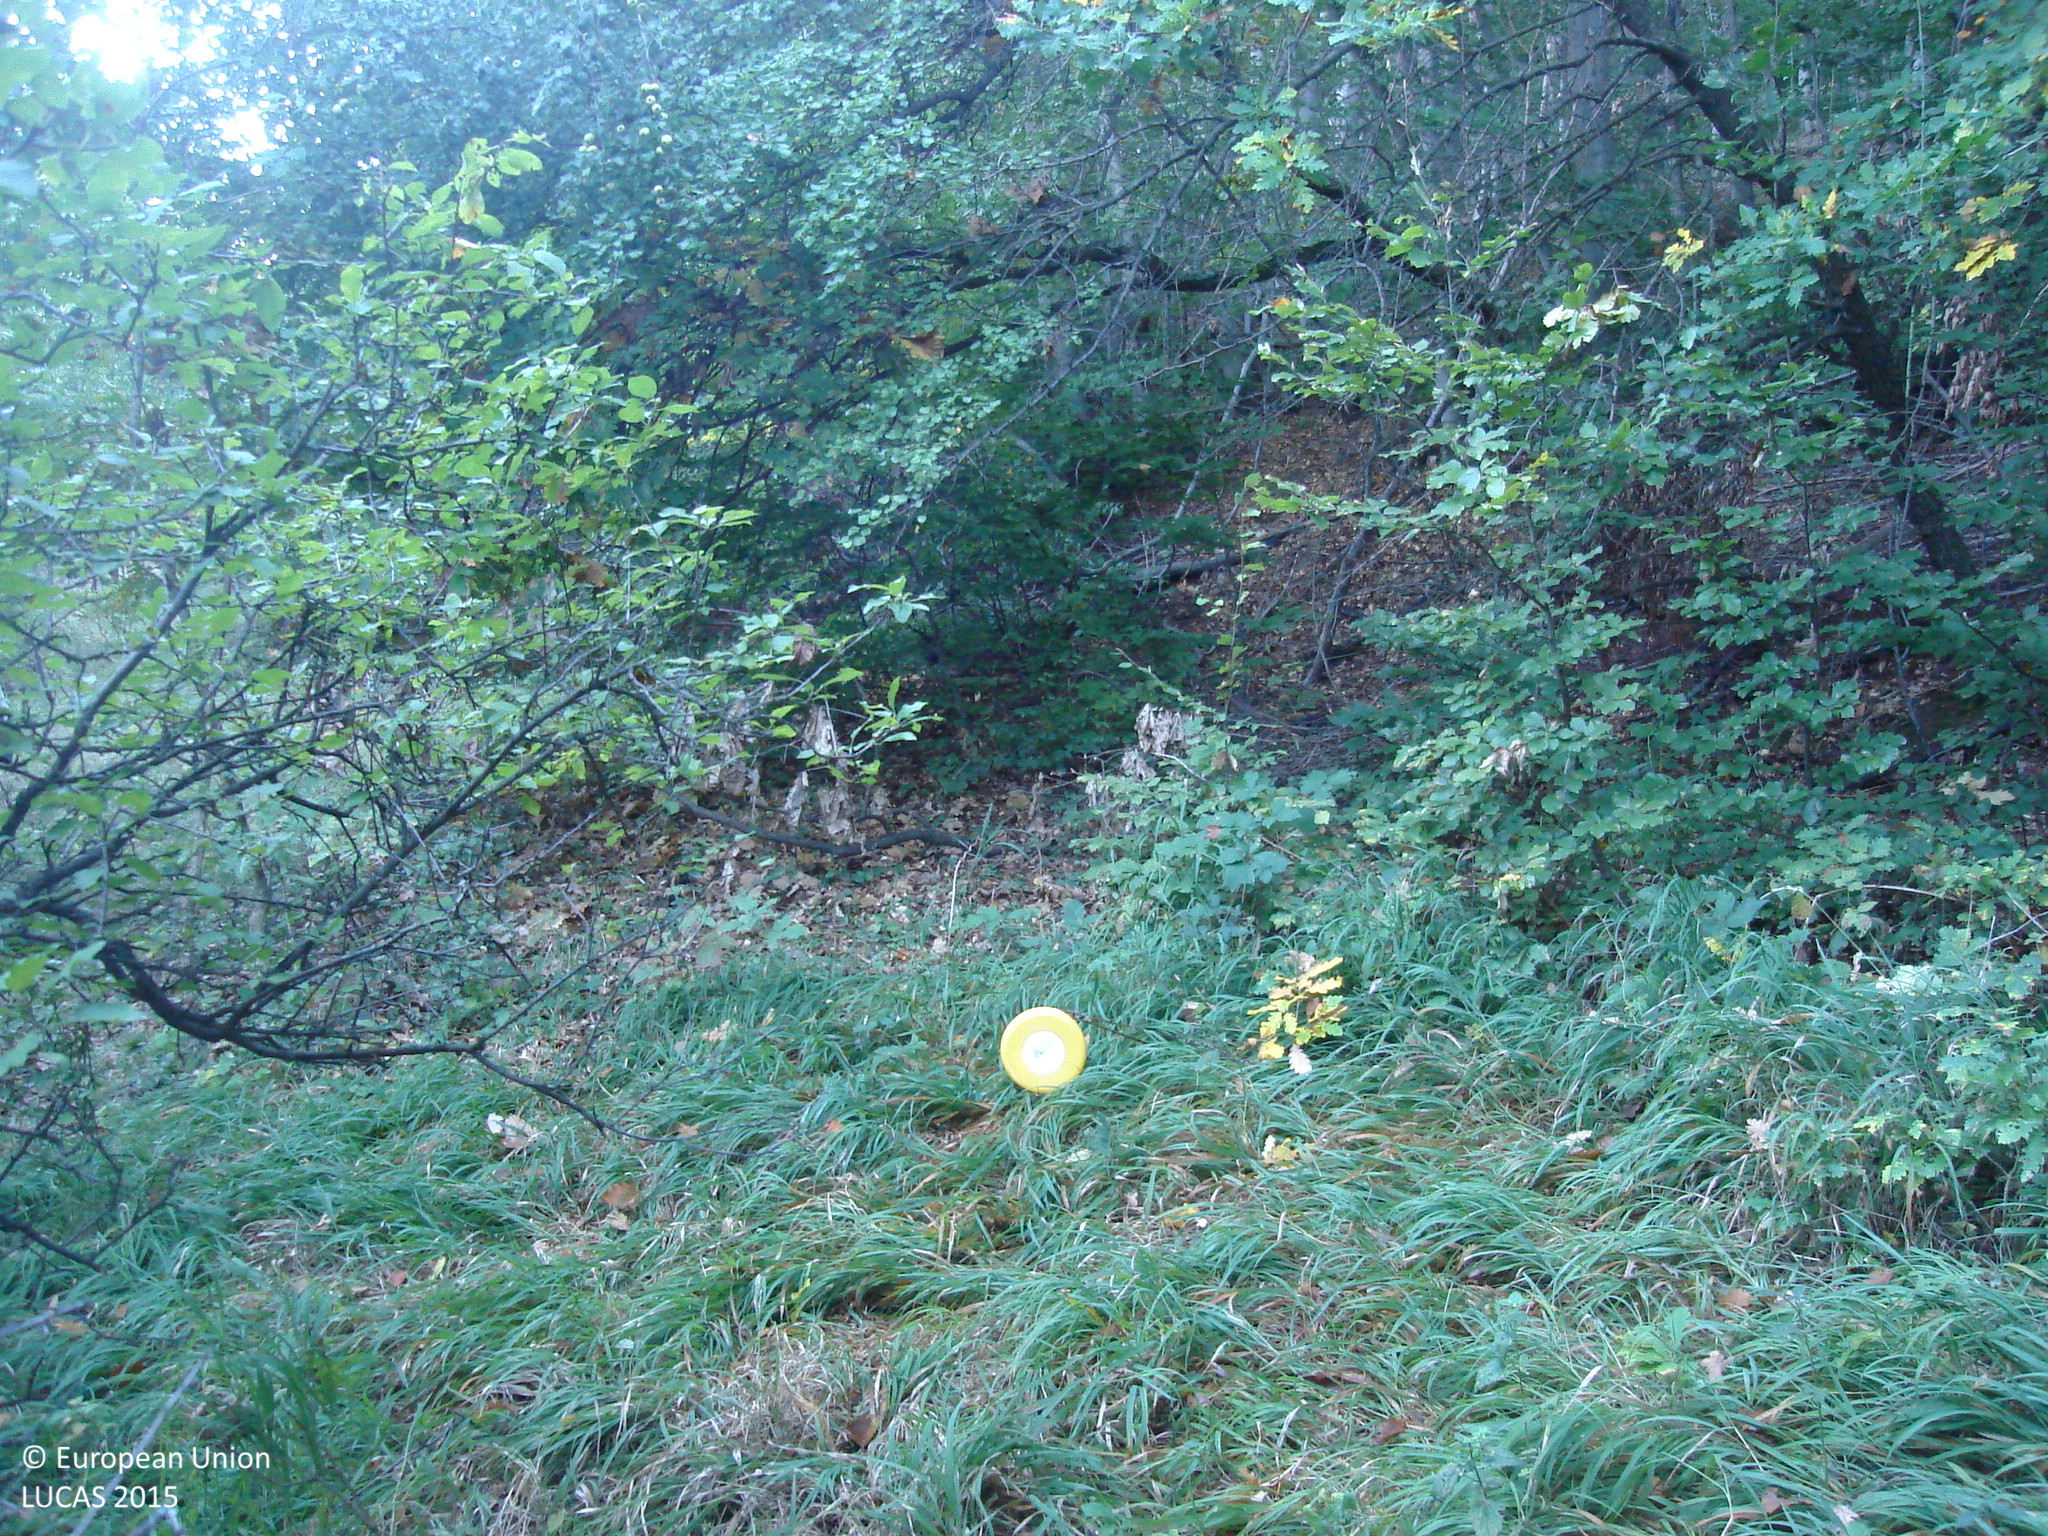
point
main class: Woodland
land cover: Broadleaved woodland
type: mesophytic deciduous forest
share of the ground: 50 - 75 %
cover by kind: broadleaved forest trees 60 %, herbaceous plants 20 %, unconsolidated bare surface 20 %
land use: Forestry
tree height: > 5 m
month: October
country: BG
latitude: 42.5131
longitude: 23.9041
